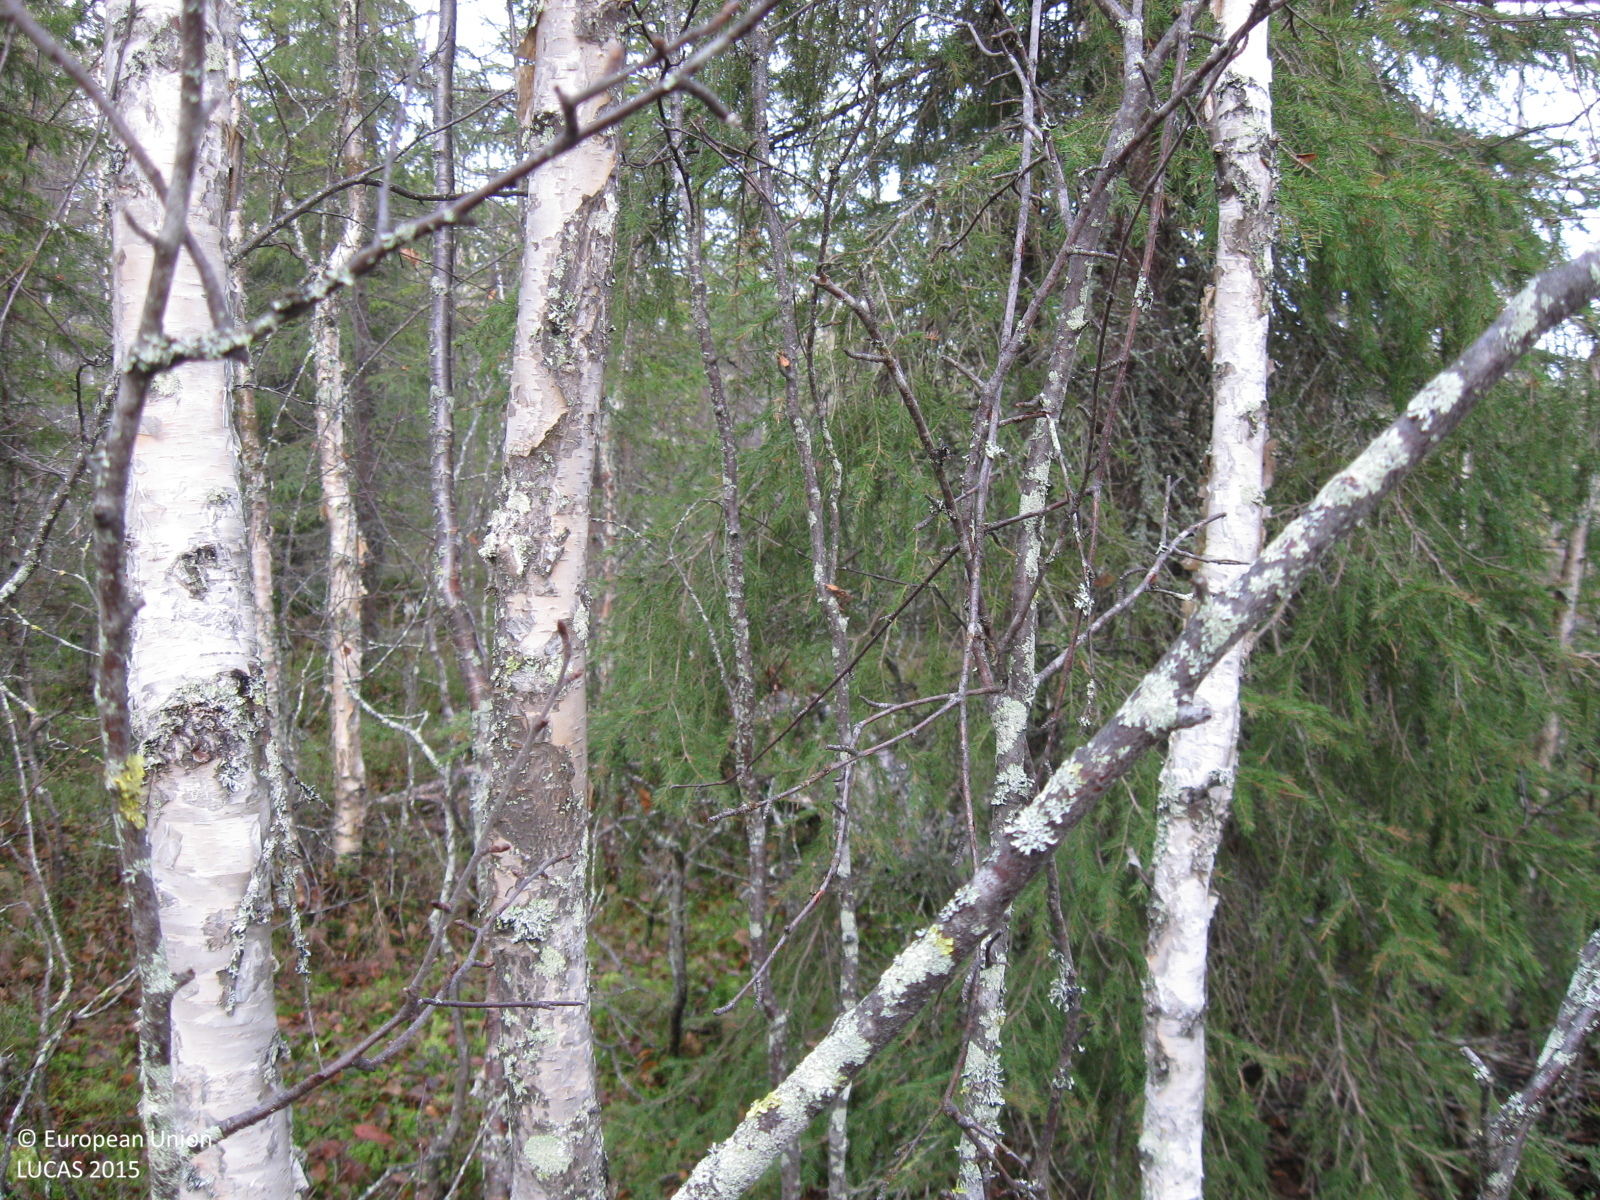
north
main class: Woodland
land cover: Broadleaved woodland
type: mire and swamp forests
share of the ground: > 75 %
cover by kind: broadleaved forest trees 70 %, coniferous forest trees 15 %, shrubs 5 %, herbaceous plants 5 %, lichens and mosses 5 %
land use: Forestry
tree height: > 5 m
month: October
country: SE
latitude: 66.5768
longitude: 21.7993
